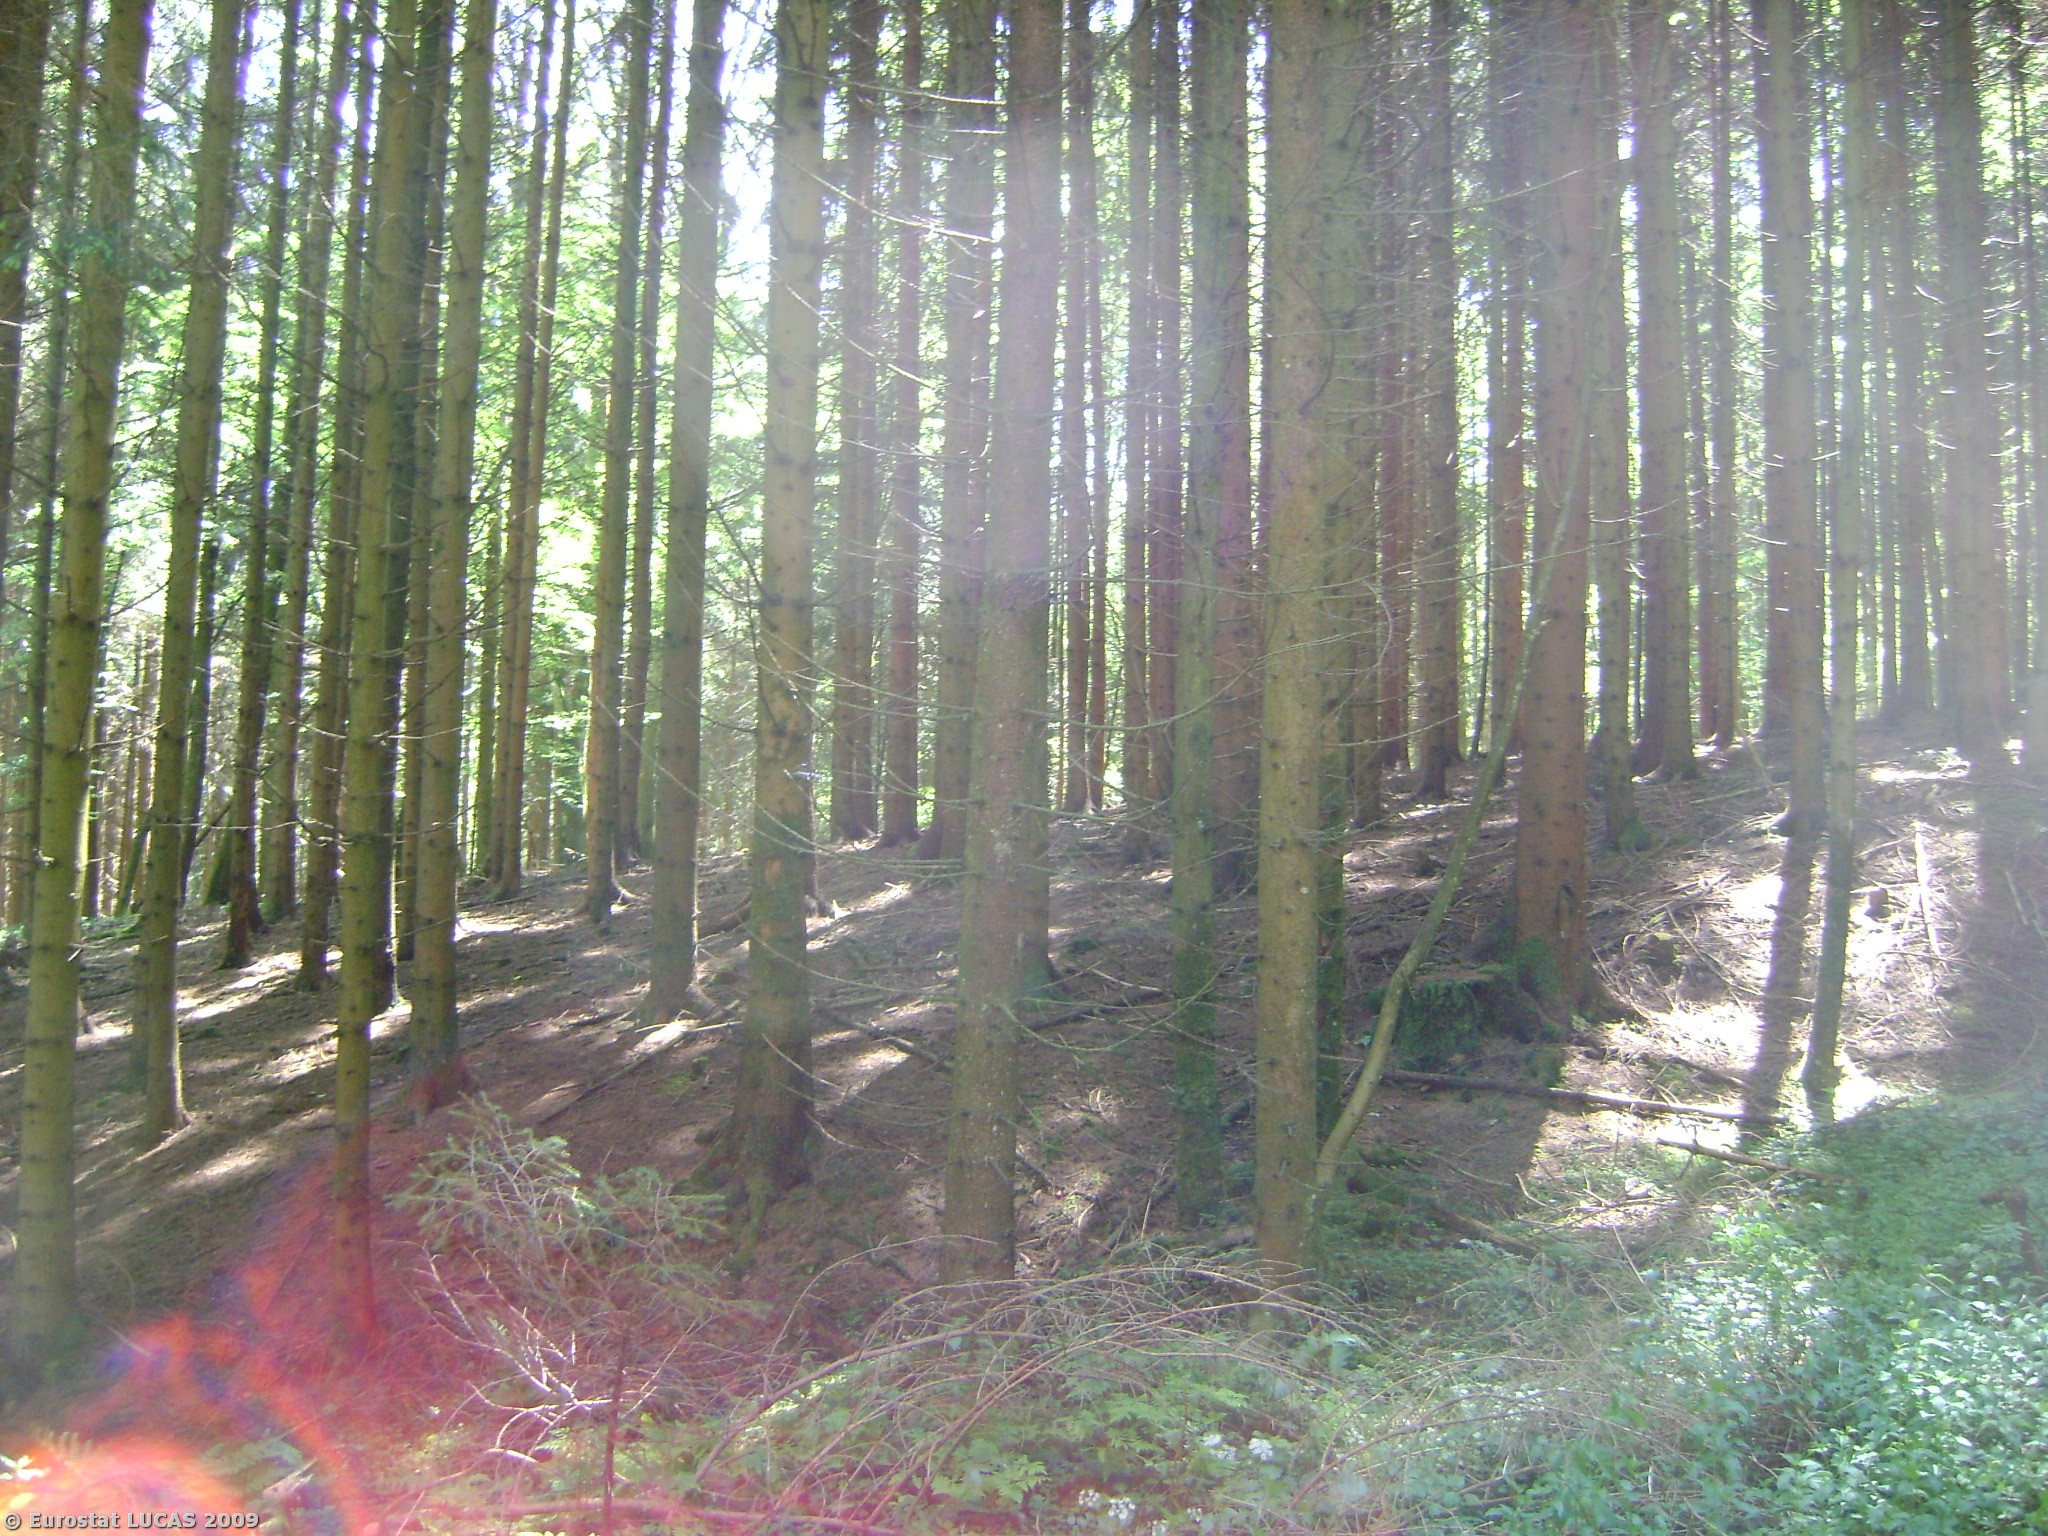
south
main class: Woodland
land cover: Coniferous woodland
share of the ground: > 75 %
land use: Forestry
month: May
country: AT
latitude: 47.8793
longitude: 13.5156
